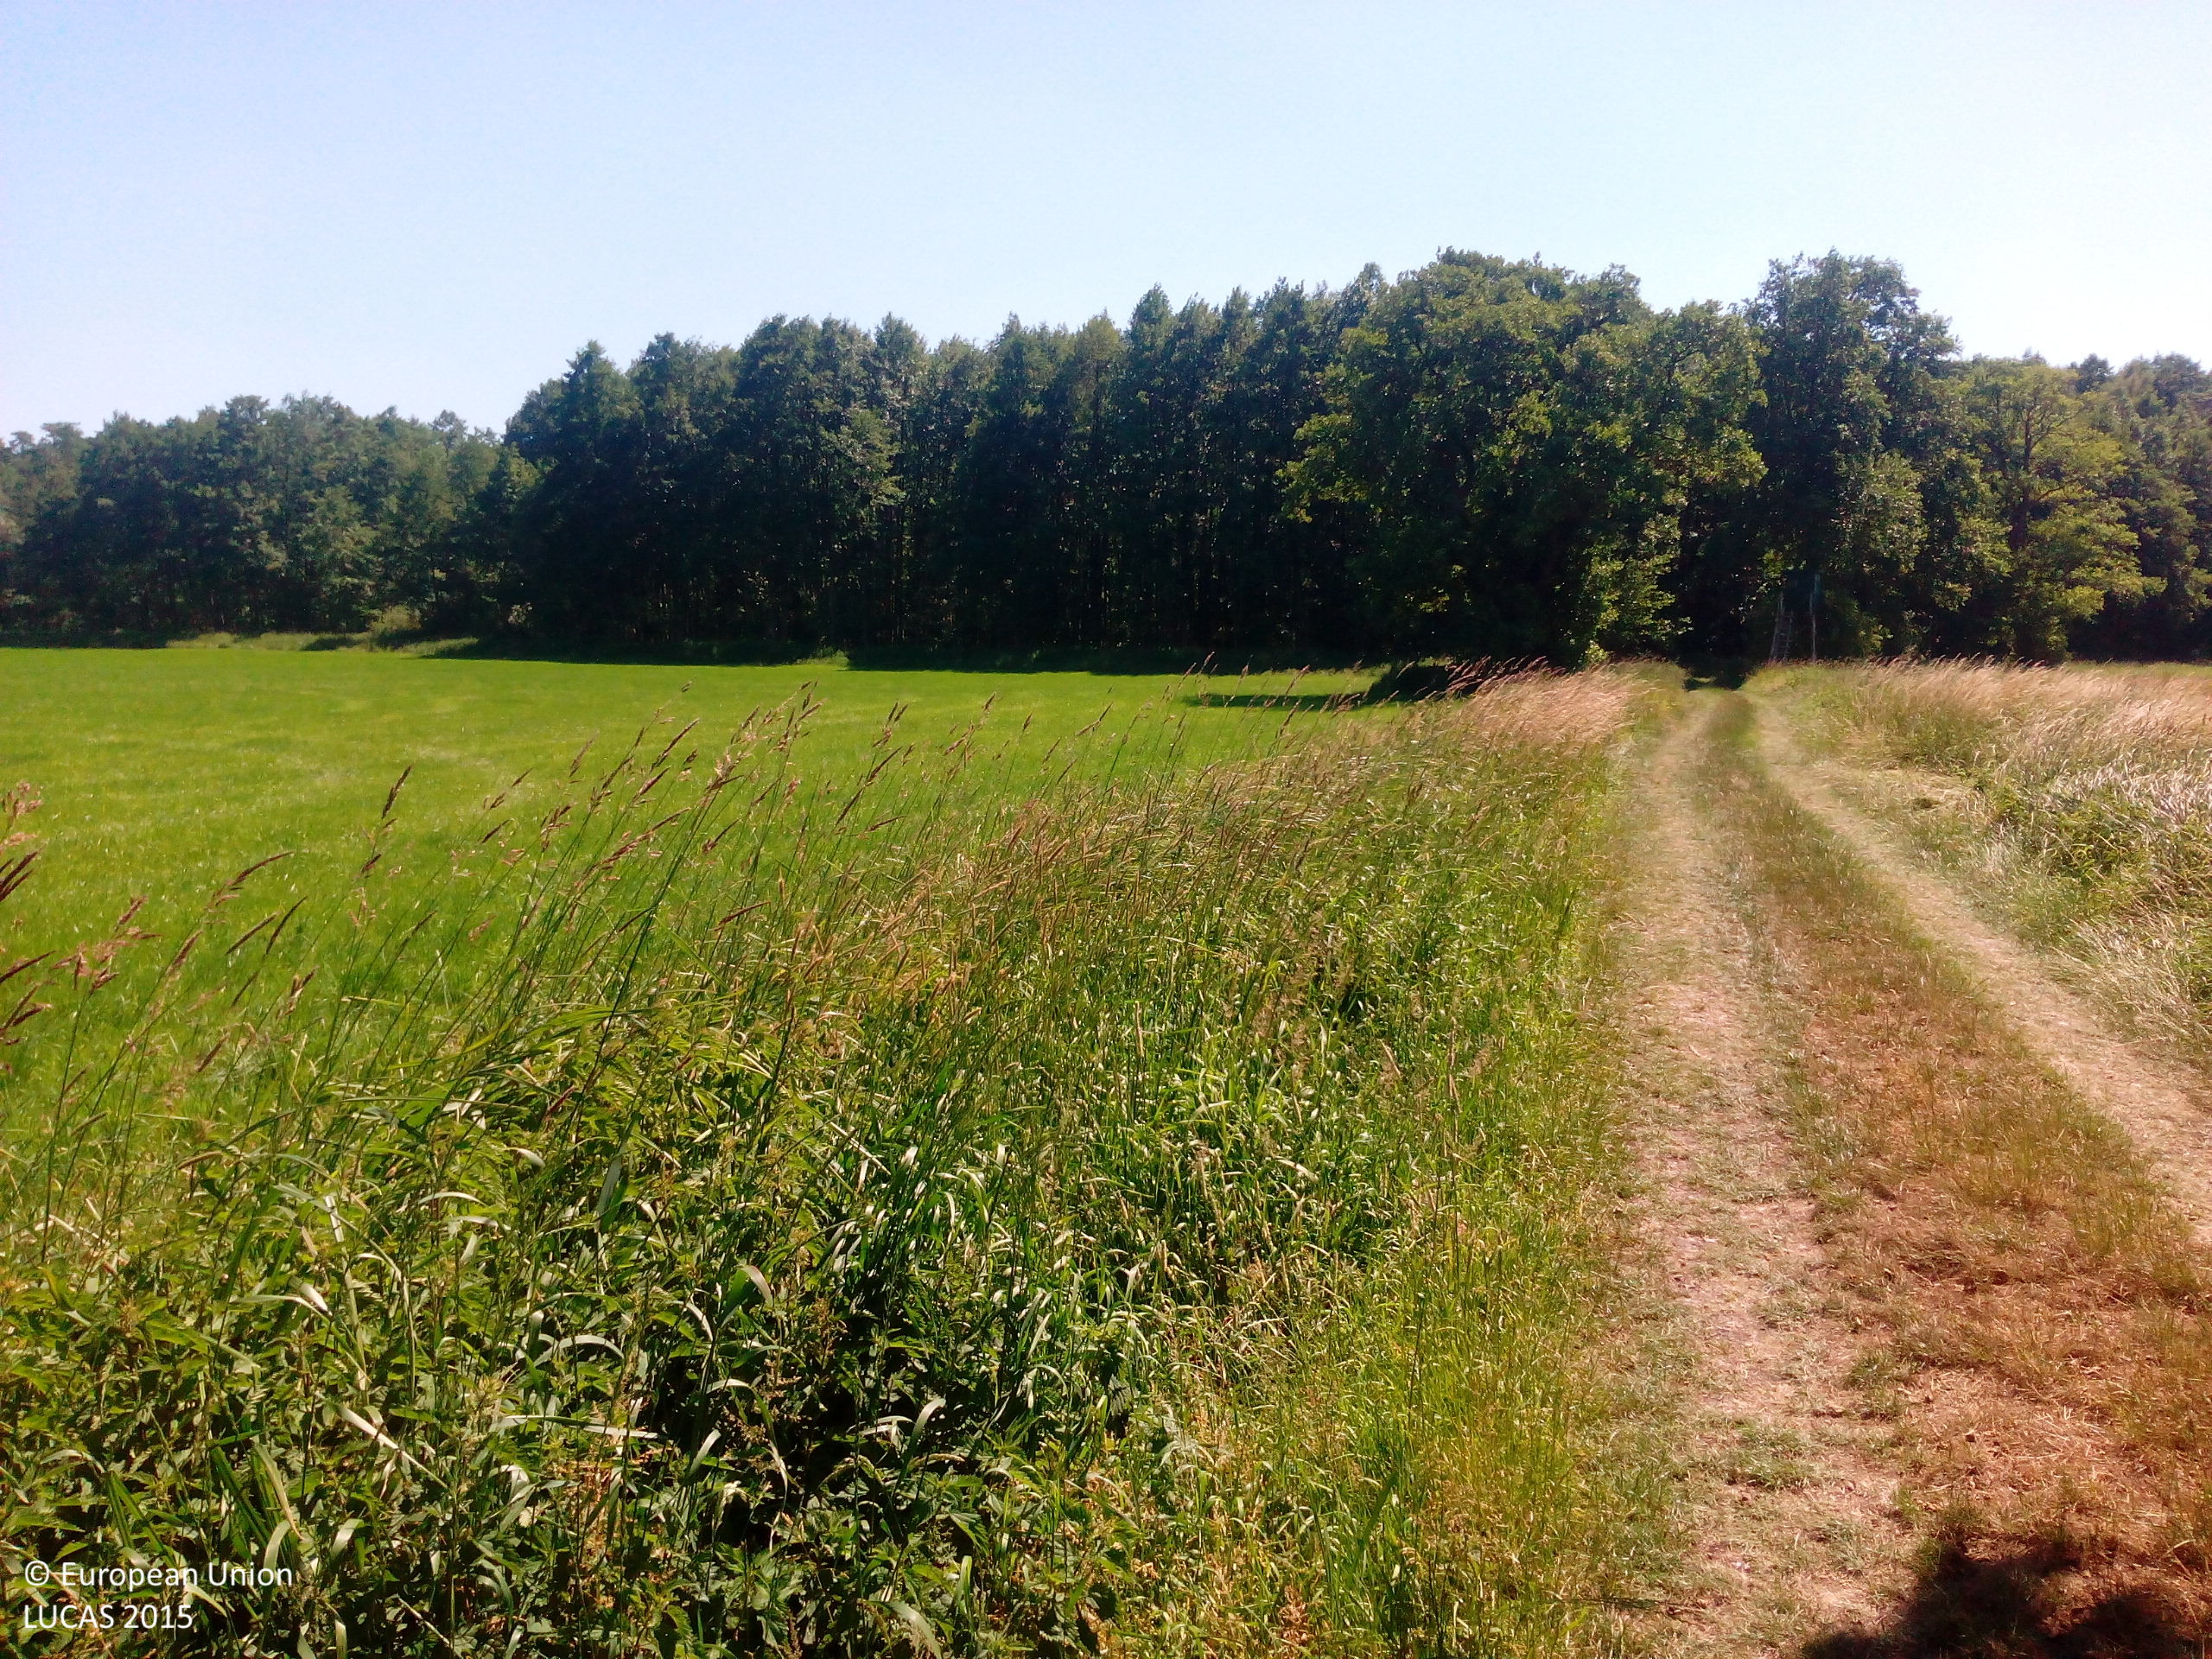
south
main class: Grassland
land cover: Grassland without tree/shrub cover
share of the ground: > 75 %
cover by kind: herbaceous plants 100 %
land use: Agriculture (excluding fallow land and kitchen gardens)
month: July
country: DE
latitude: 52.5928
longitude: 10.2804
